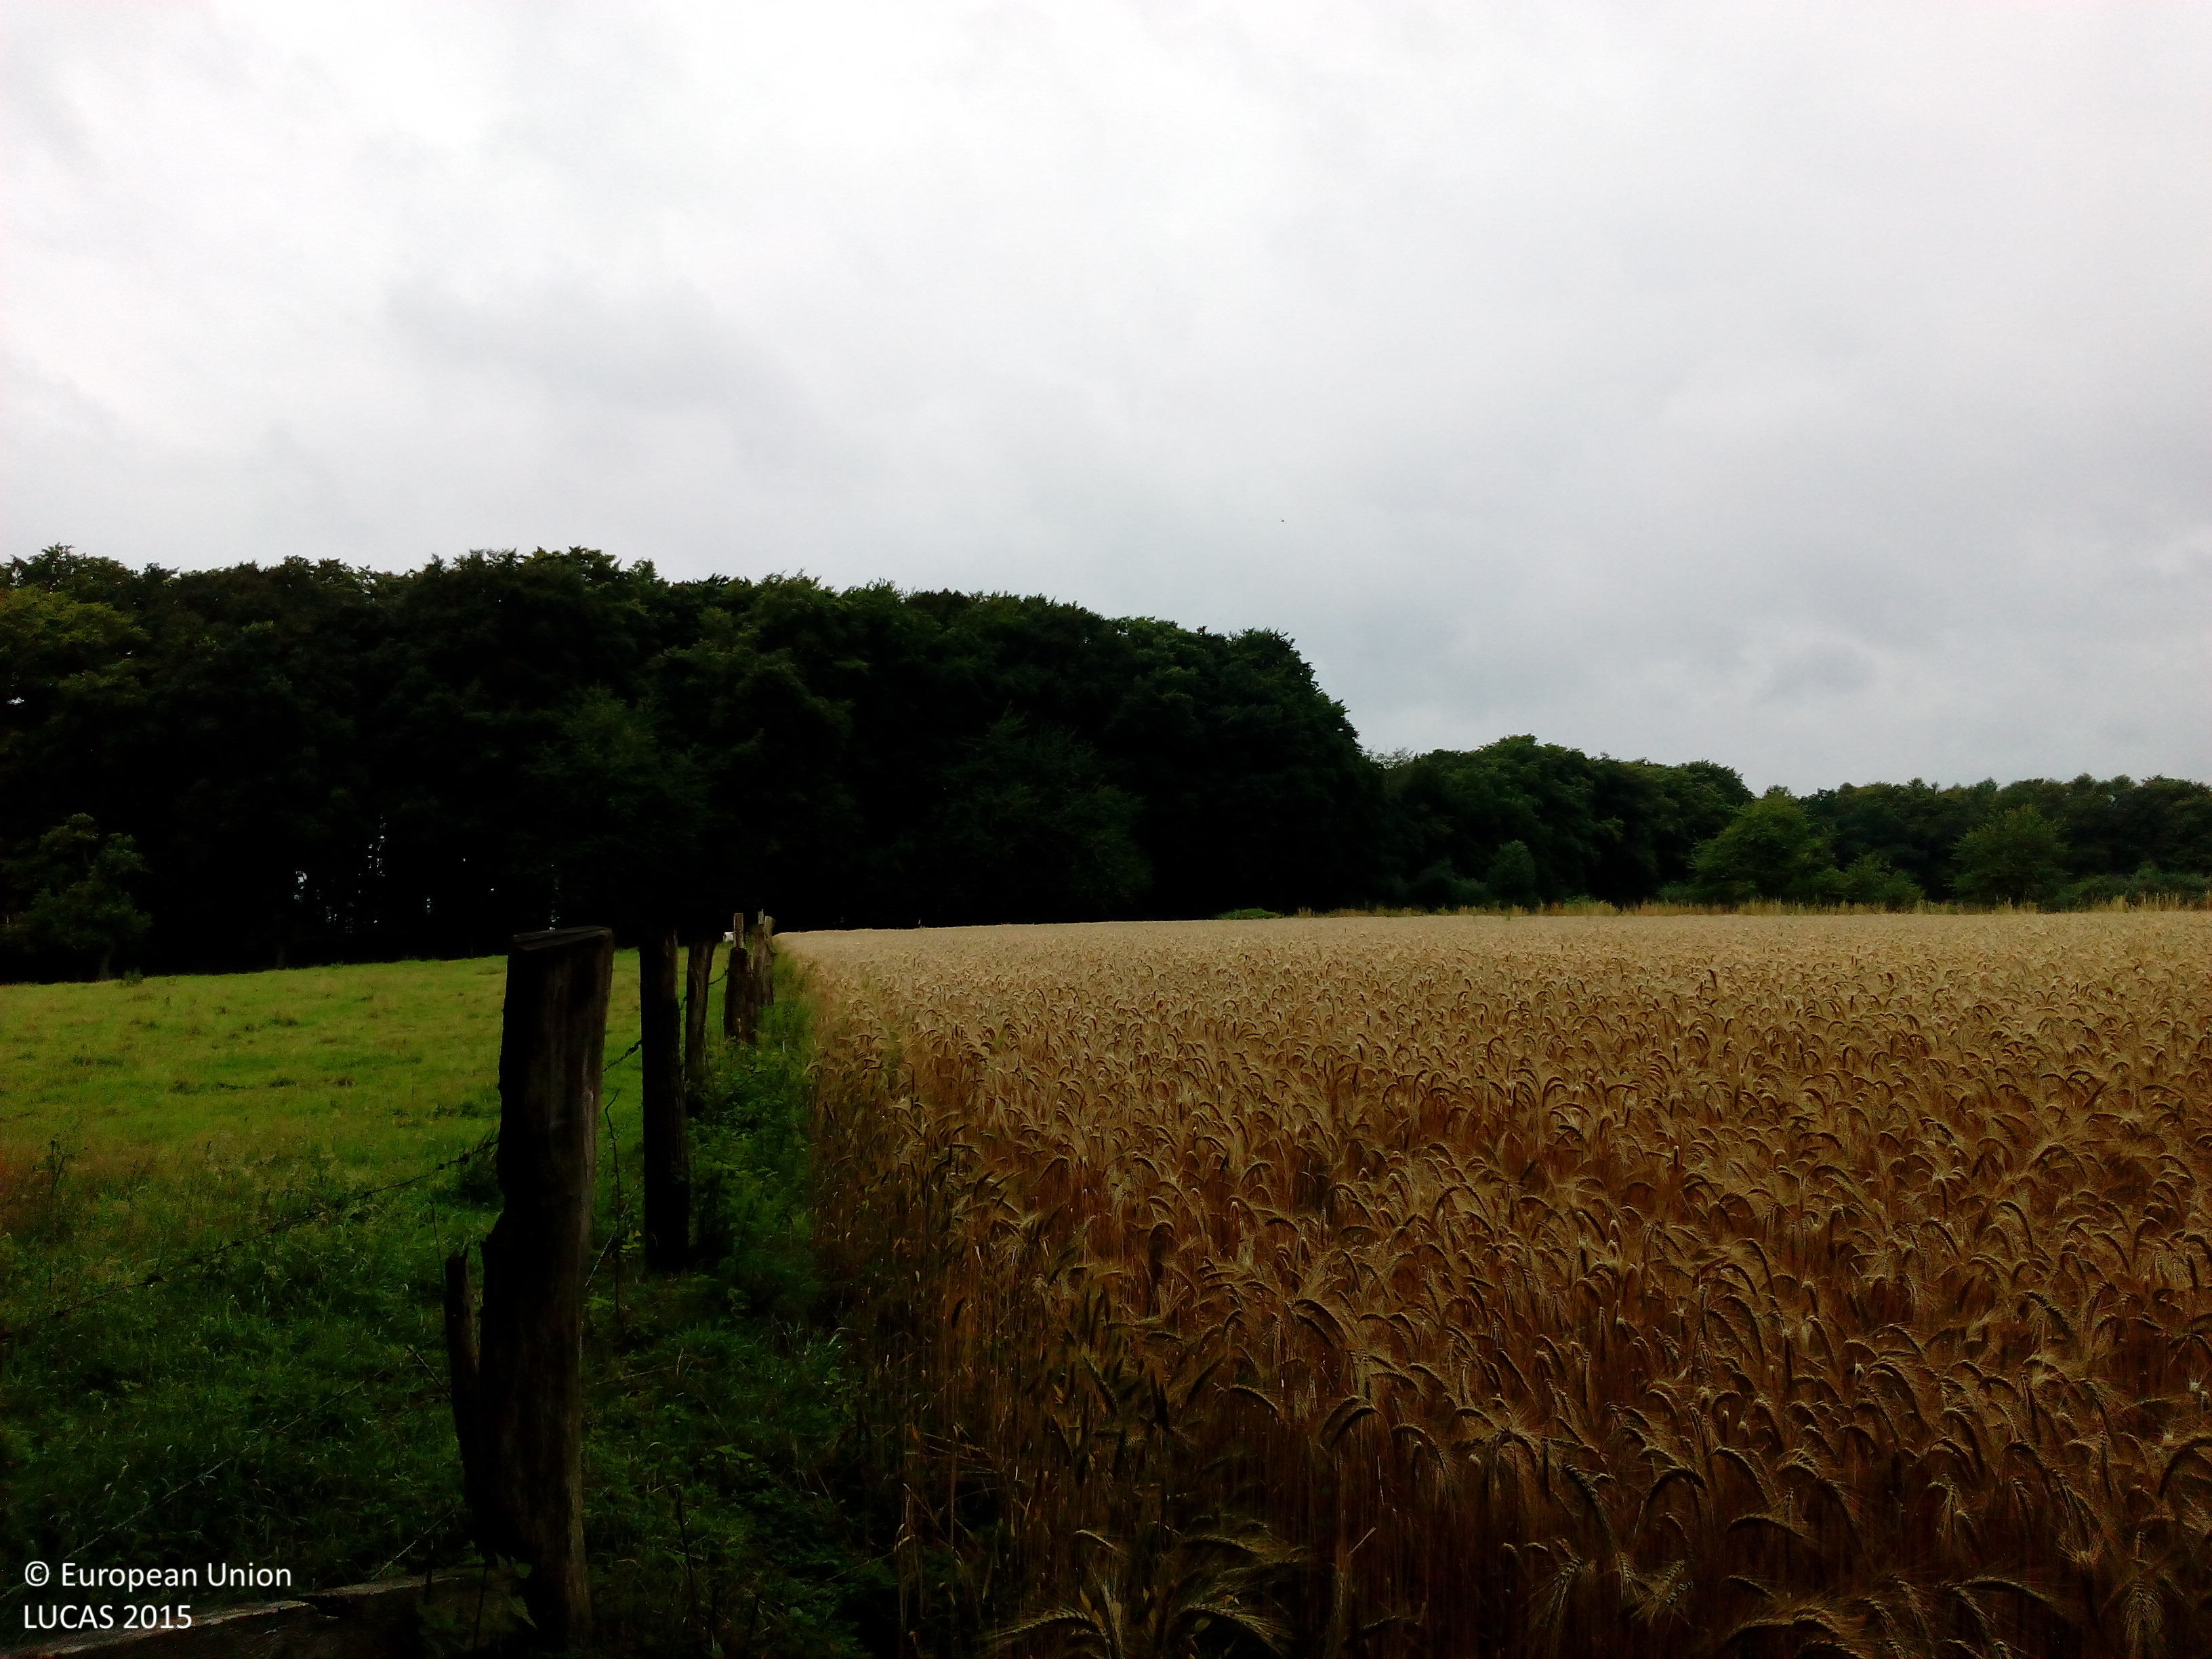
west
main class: Cropland
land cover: Triticale
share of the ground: > 75 %
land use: Agriculture (excluding fallow land and kitchen gardens)
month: July
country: DE
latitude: 52.3425
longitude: 7.9895
